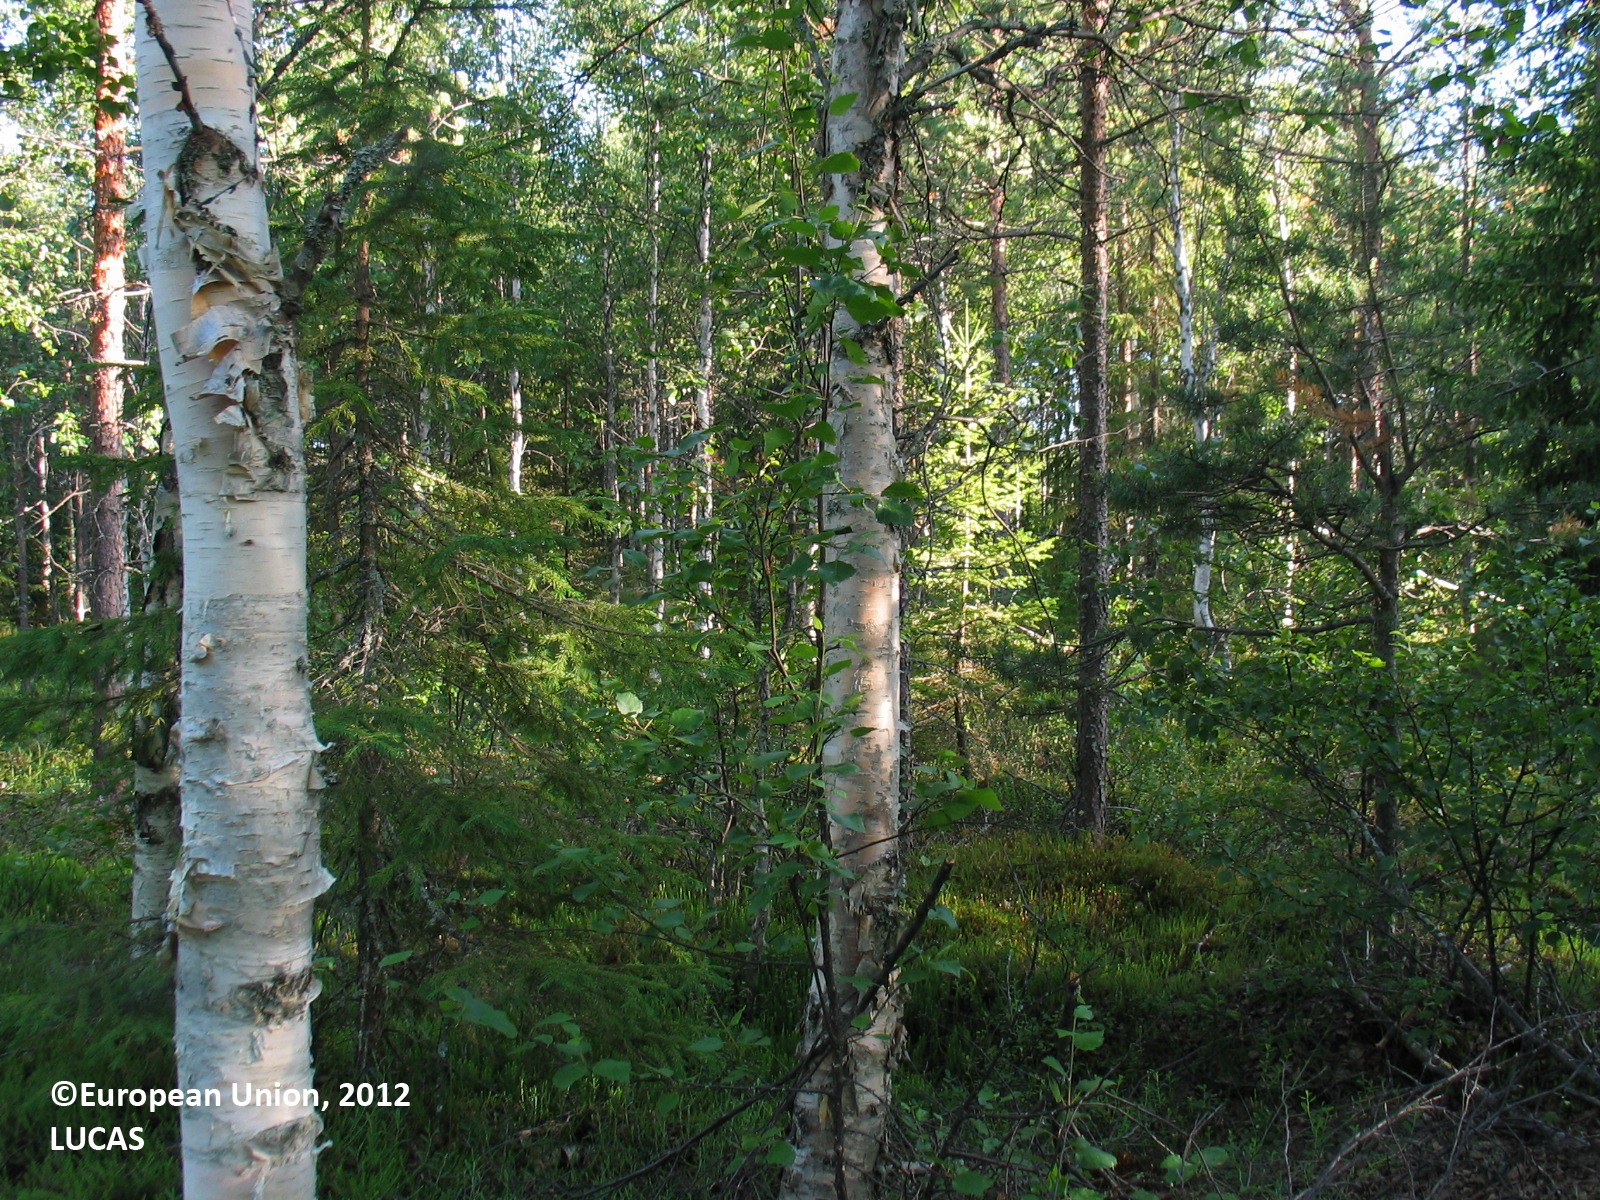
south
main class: Woodland
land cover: Broadleaved woodland
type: boreal forest
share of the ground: 25 - 50 %
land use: Forestry
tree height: > 5 m
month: July
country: FI
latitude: 65.7983
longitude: 24.8602
